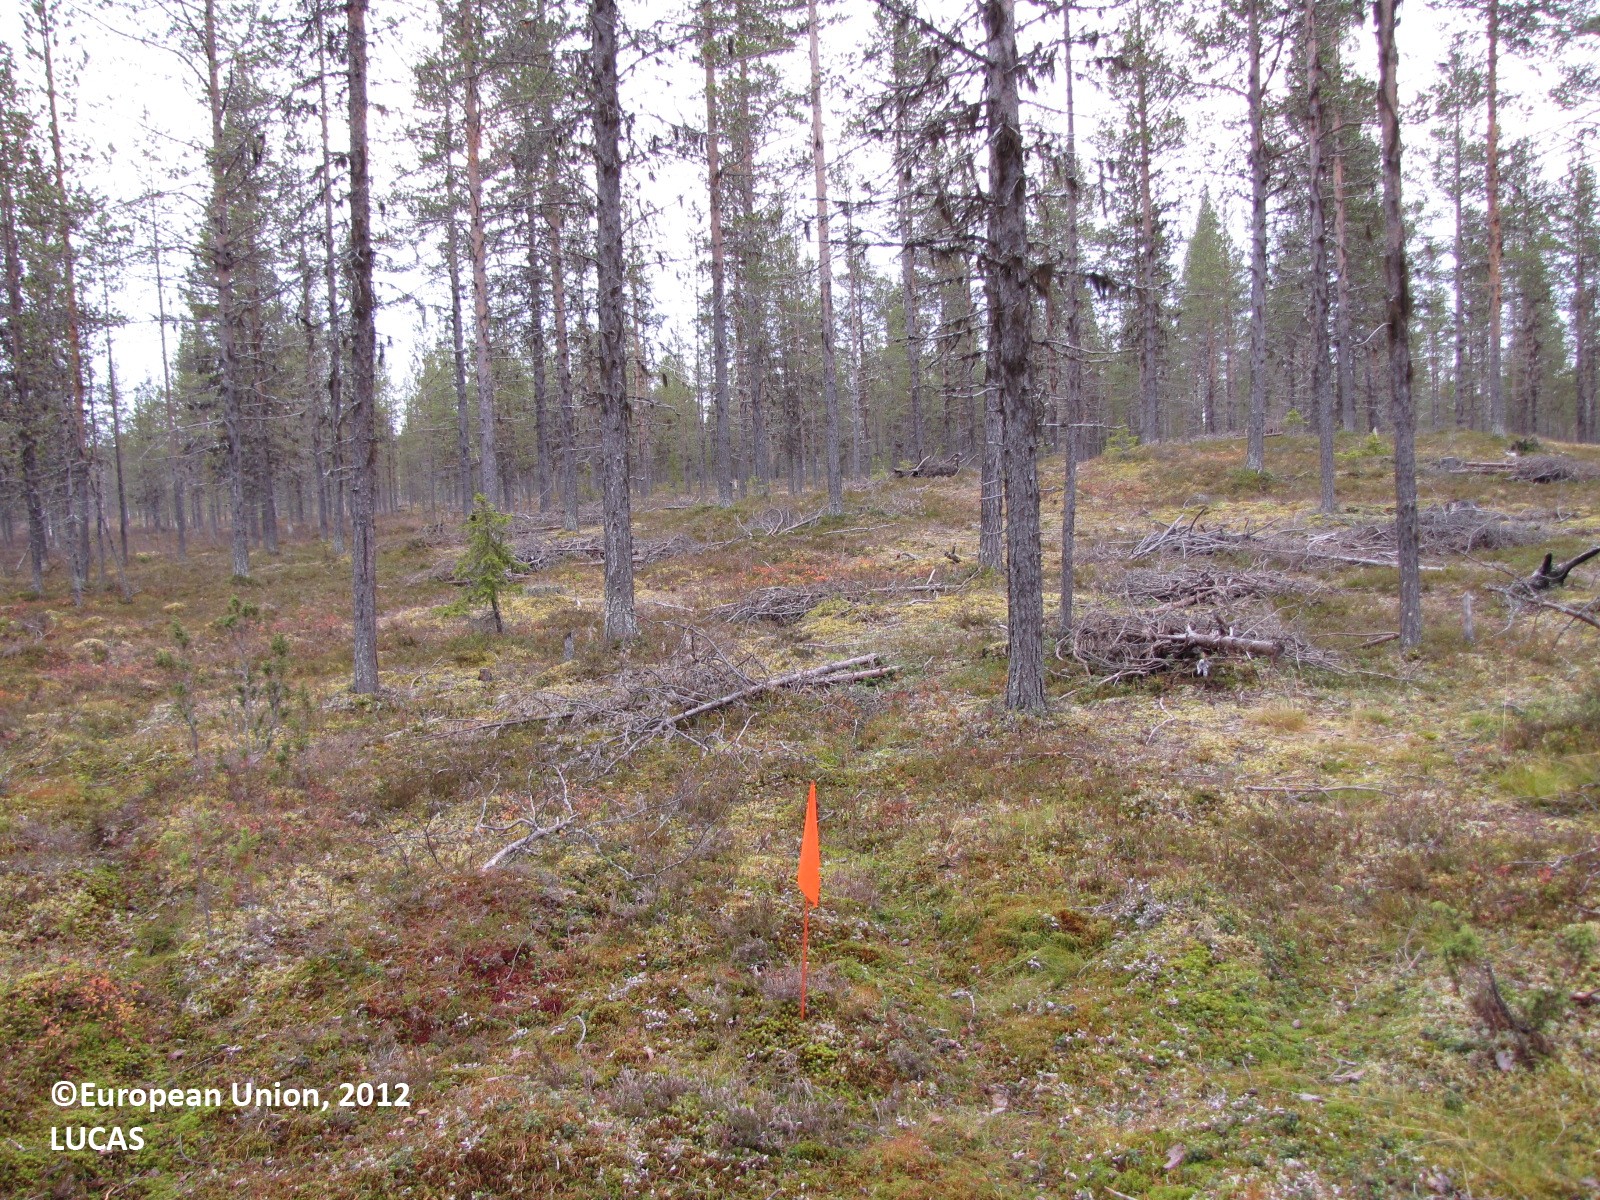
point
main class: Woodland
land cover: Pine dominated coniferous woodland
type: boreal forest
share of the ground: 25 - 50 %
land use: Forestry
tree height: > 5 m
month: September
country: FI
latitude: 67.7104
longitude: 24.1264
